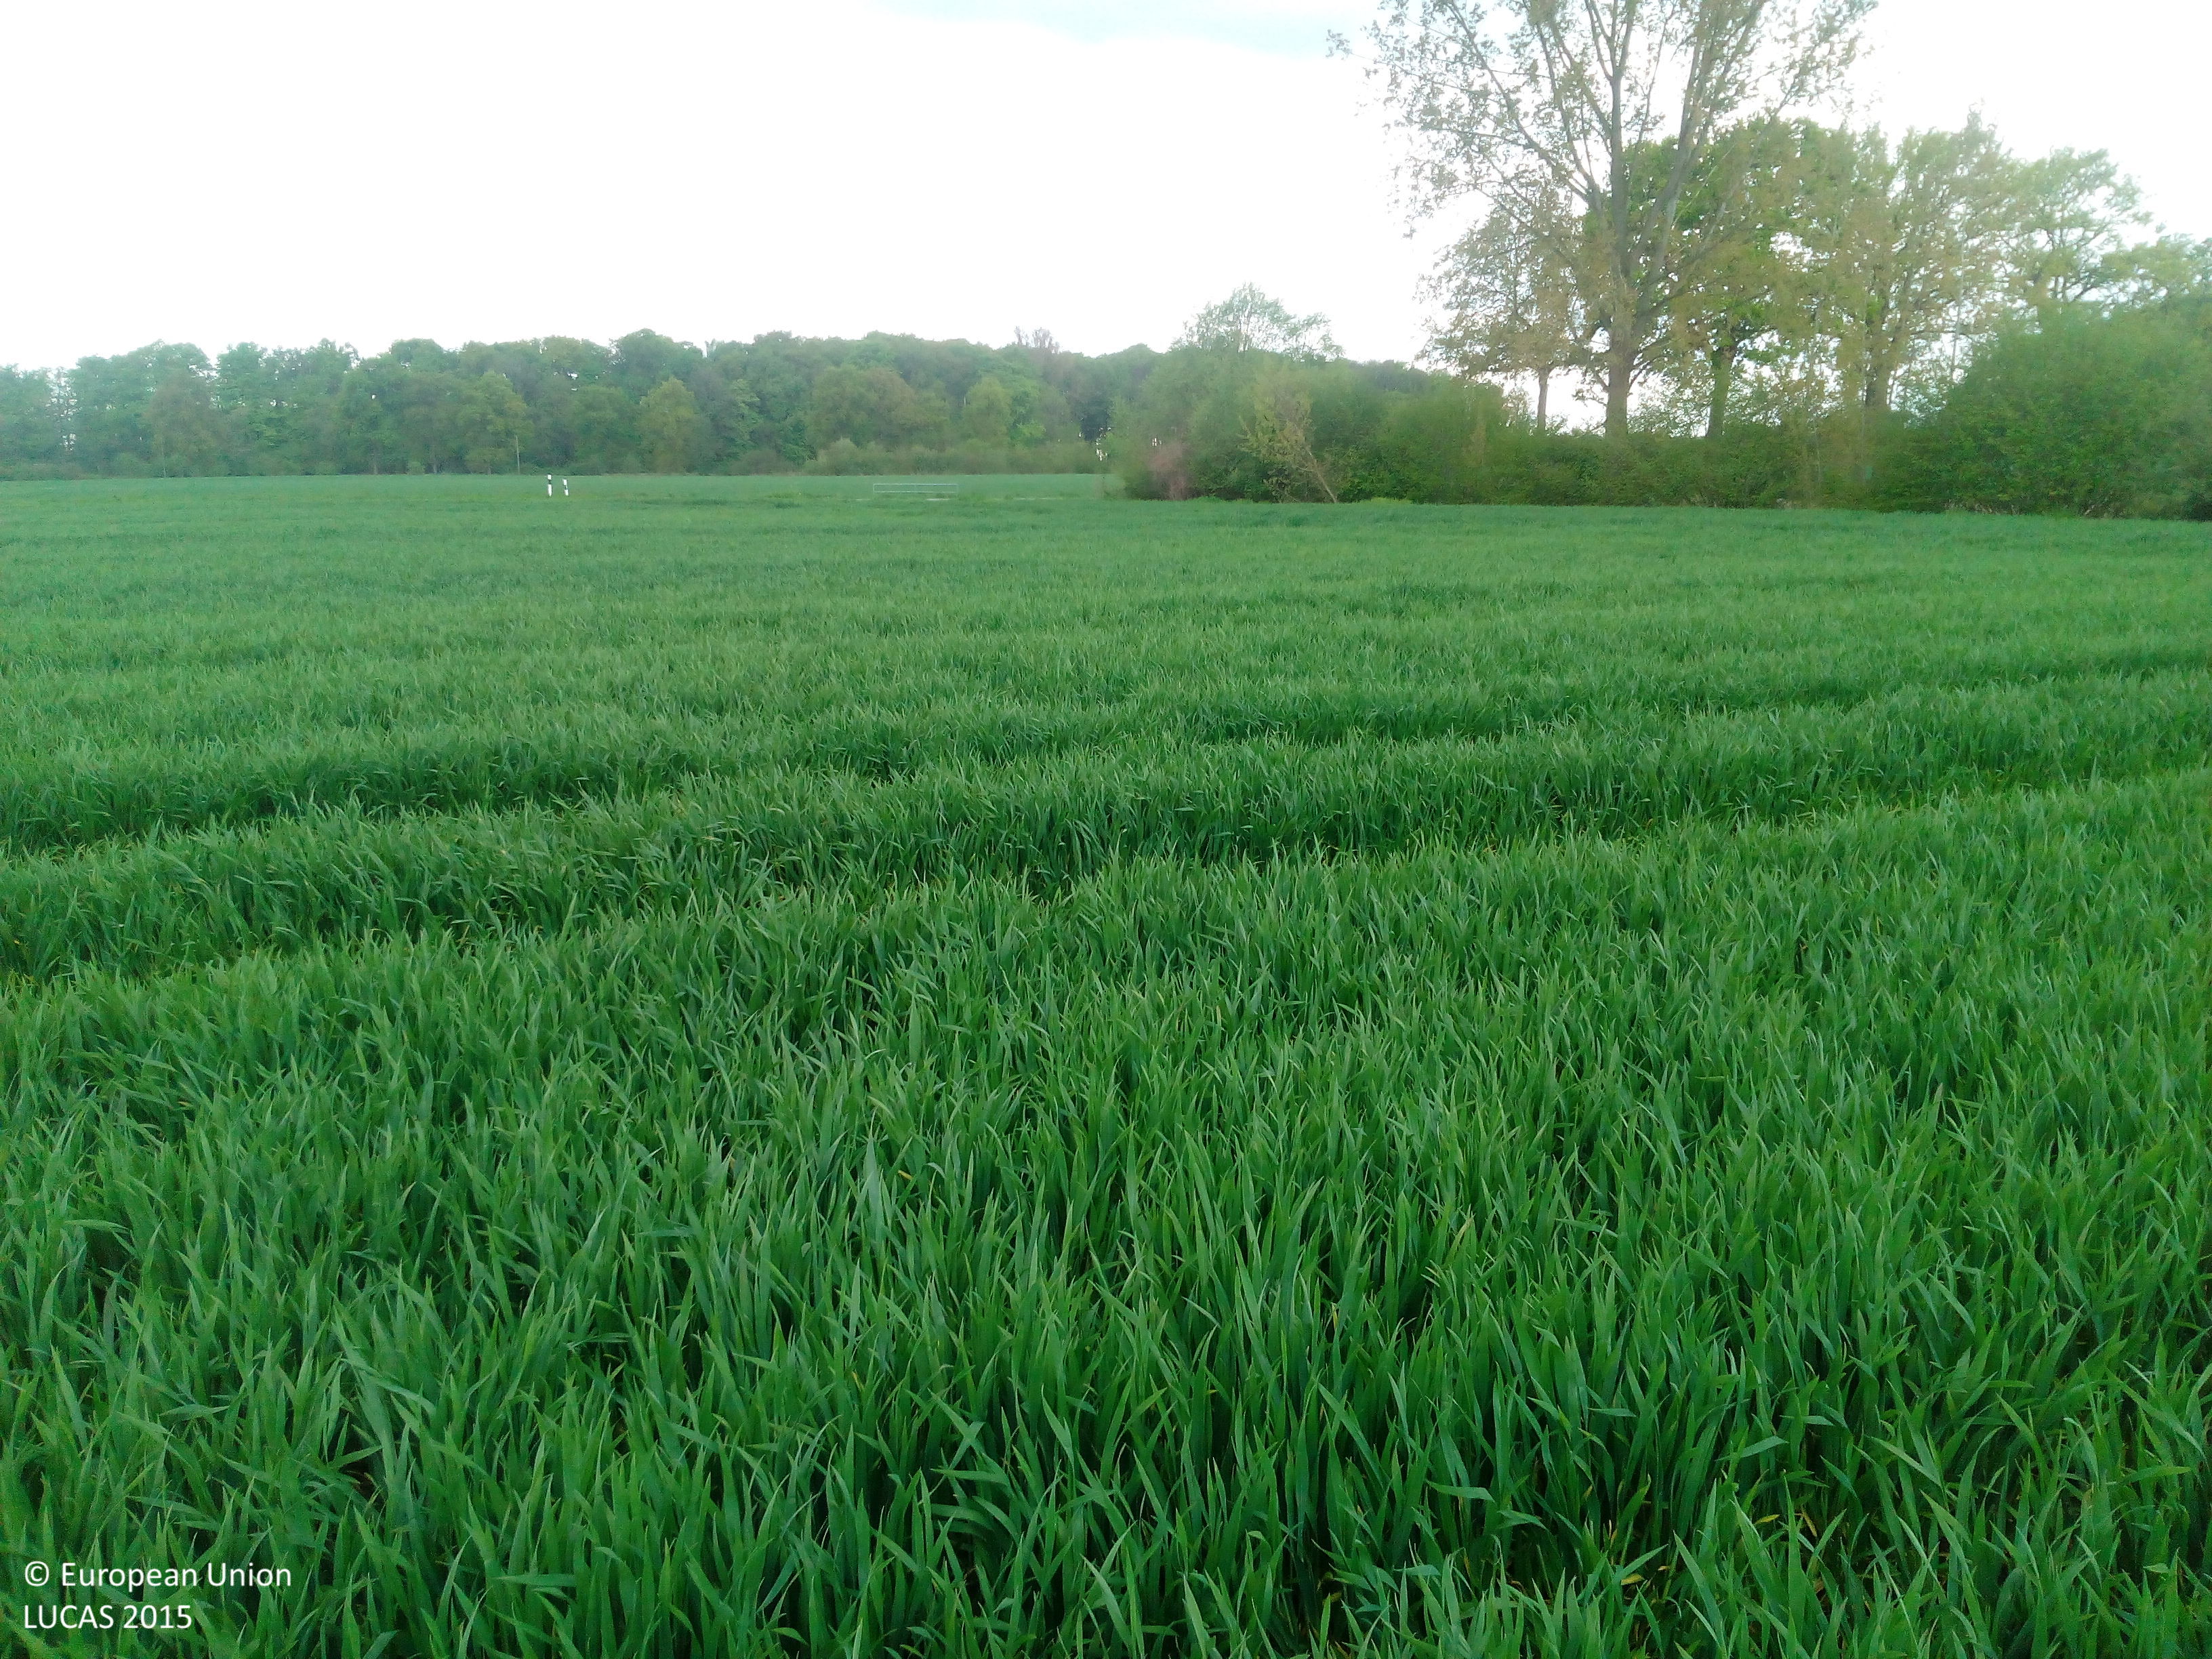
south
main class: Cropland
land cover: Triticale
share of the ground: > 75 %
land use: Agriculture (excluding fallow land and kitchen gardens)
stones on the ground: < 10 %
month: May
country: DE
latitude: 51.8635
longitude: 7.4009
